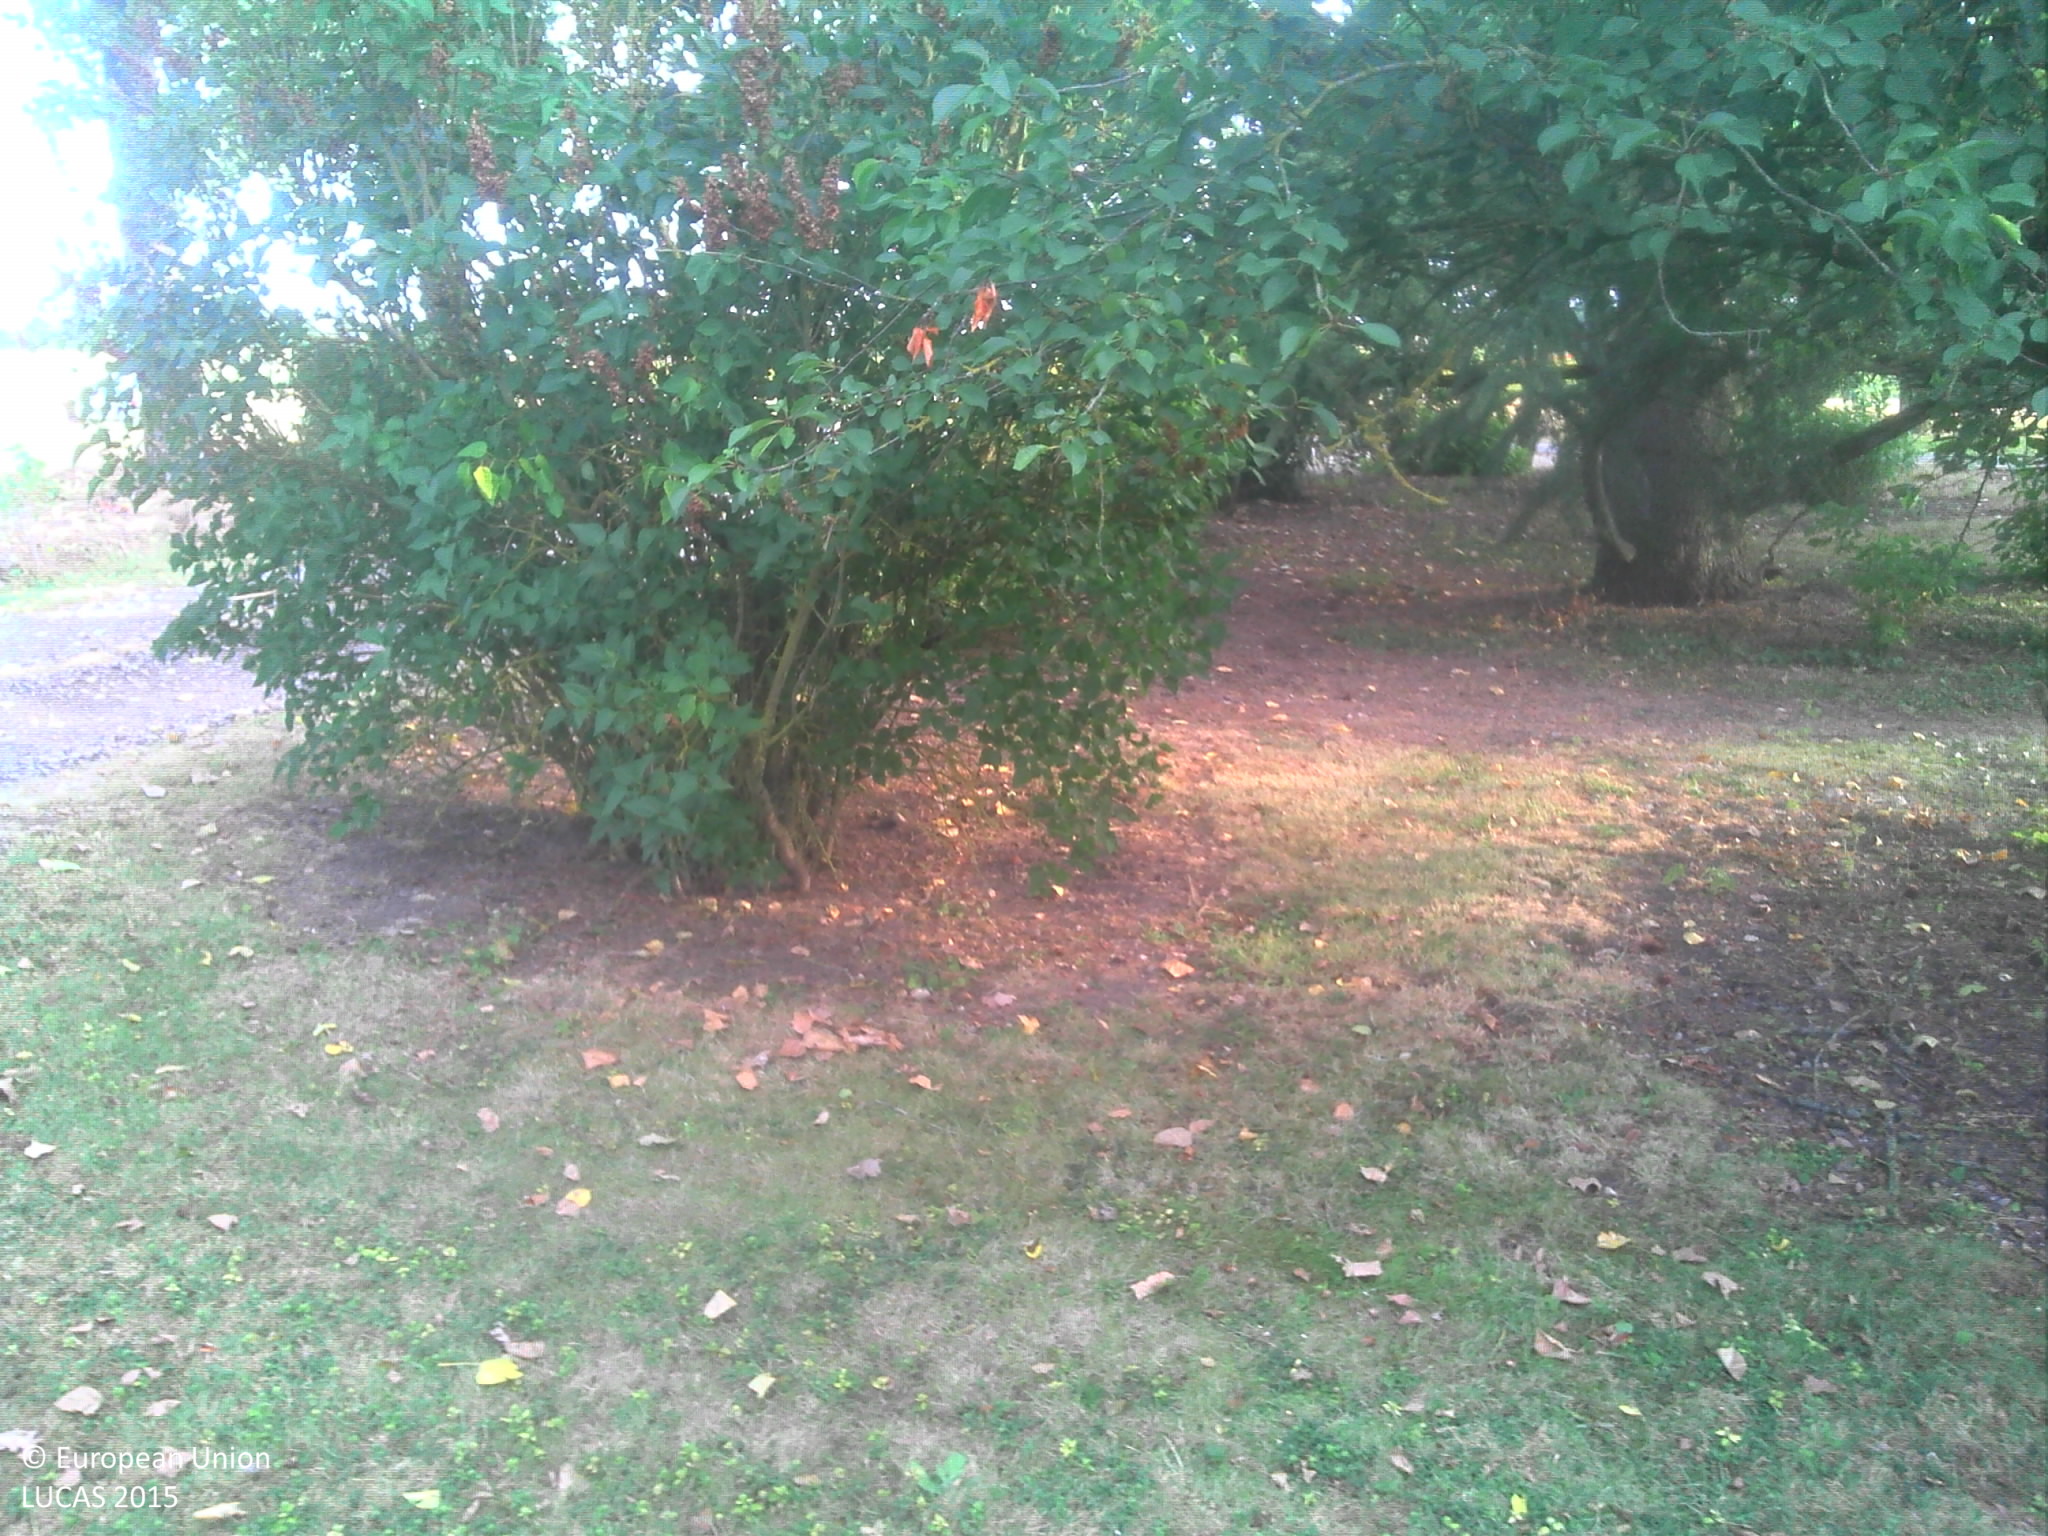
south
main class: Grassland
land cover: Grassland with sparse tree/shrub cover
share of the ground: > 75 %
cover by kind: herbaceous plants 95 %, broadleaved forest trees 5 %
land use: Residential
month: July
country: FR
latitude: 47.8206
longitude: 1.4768
